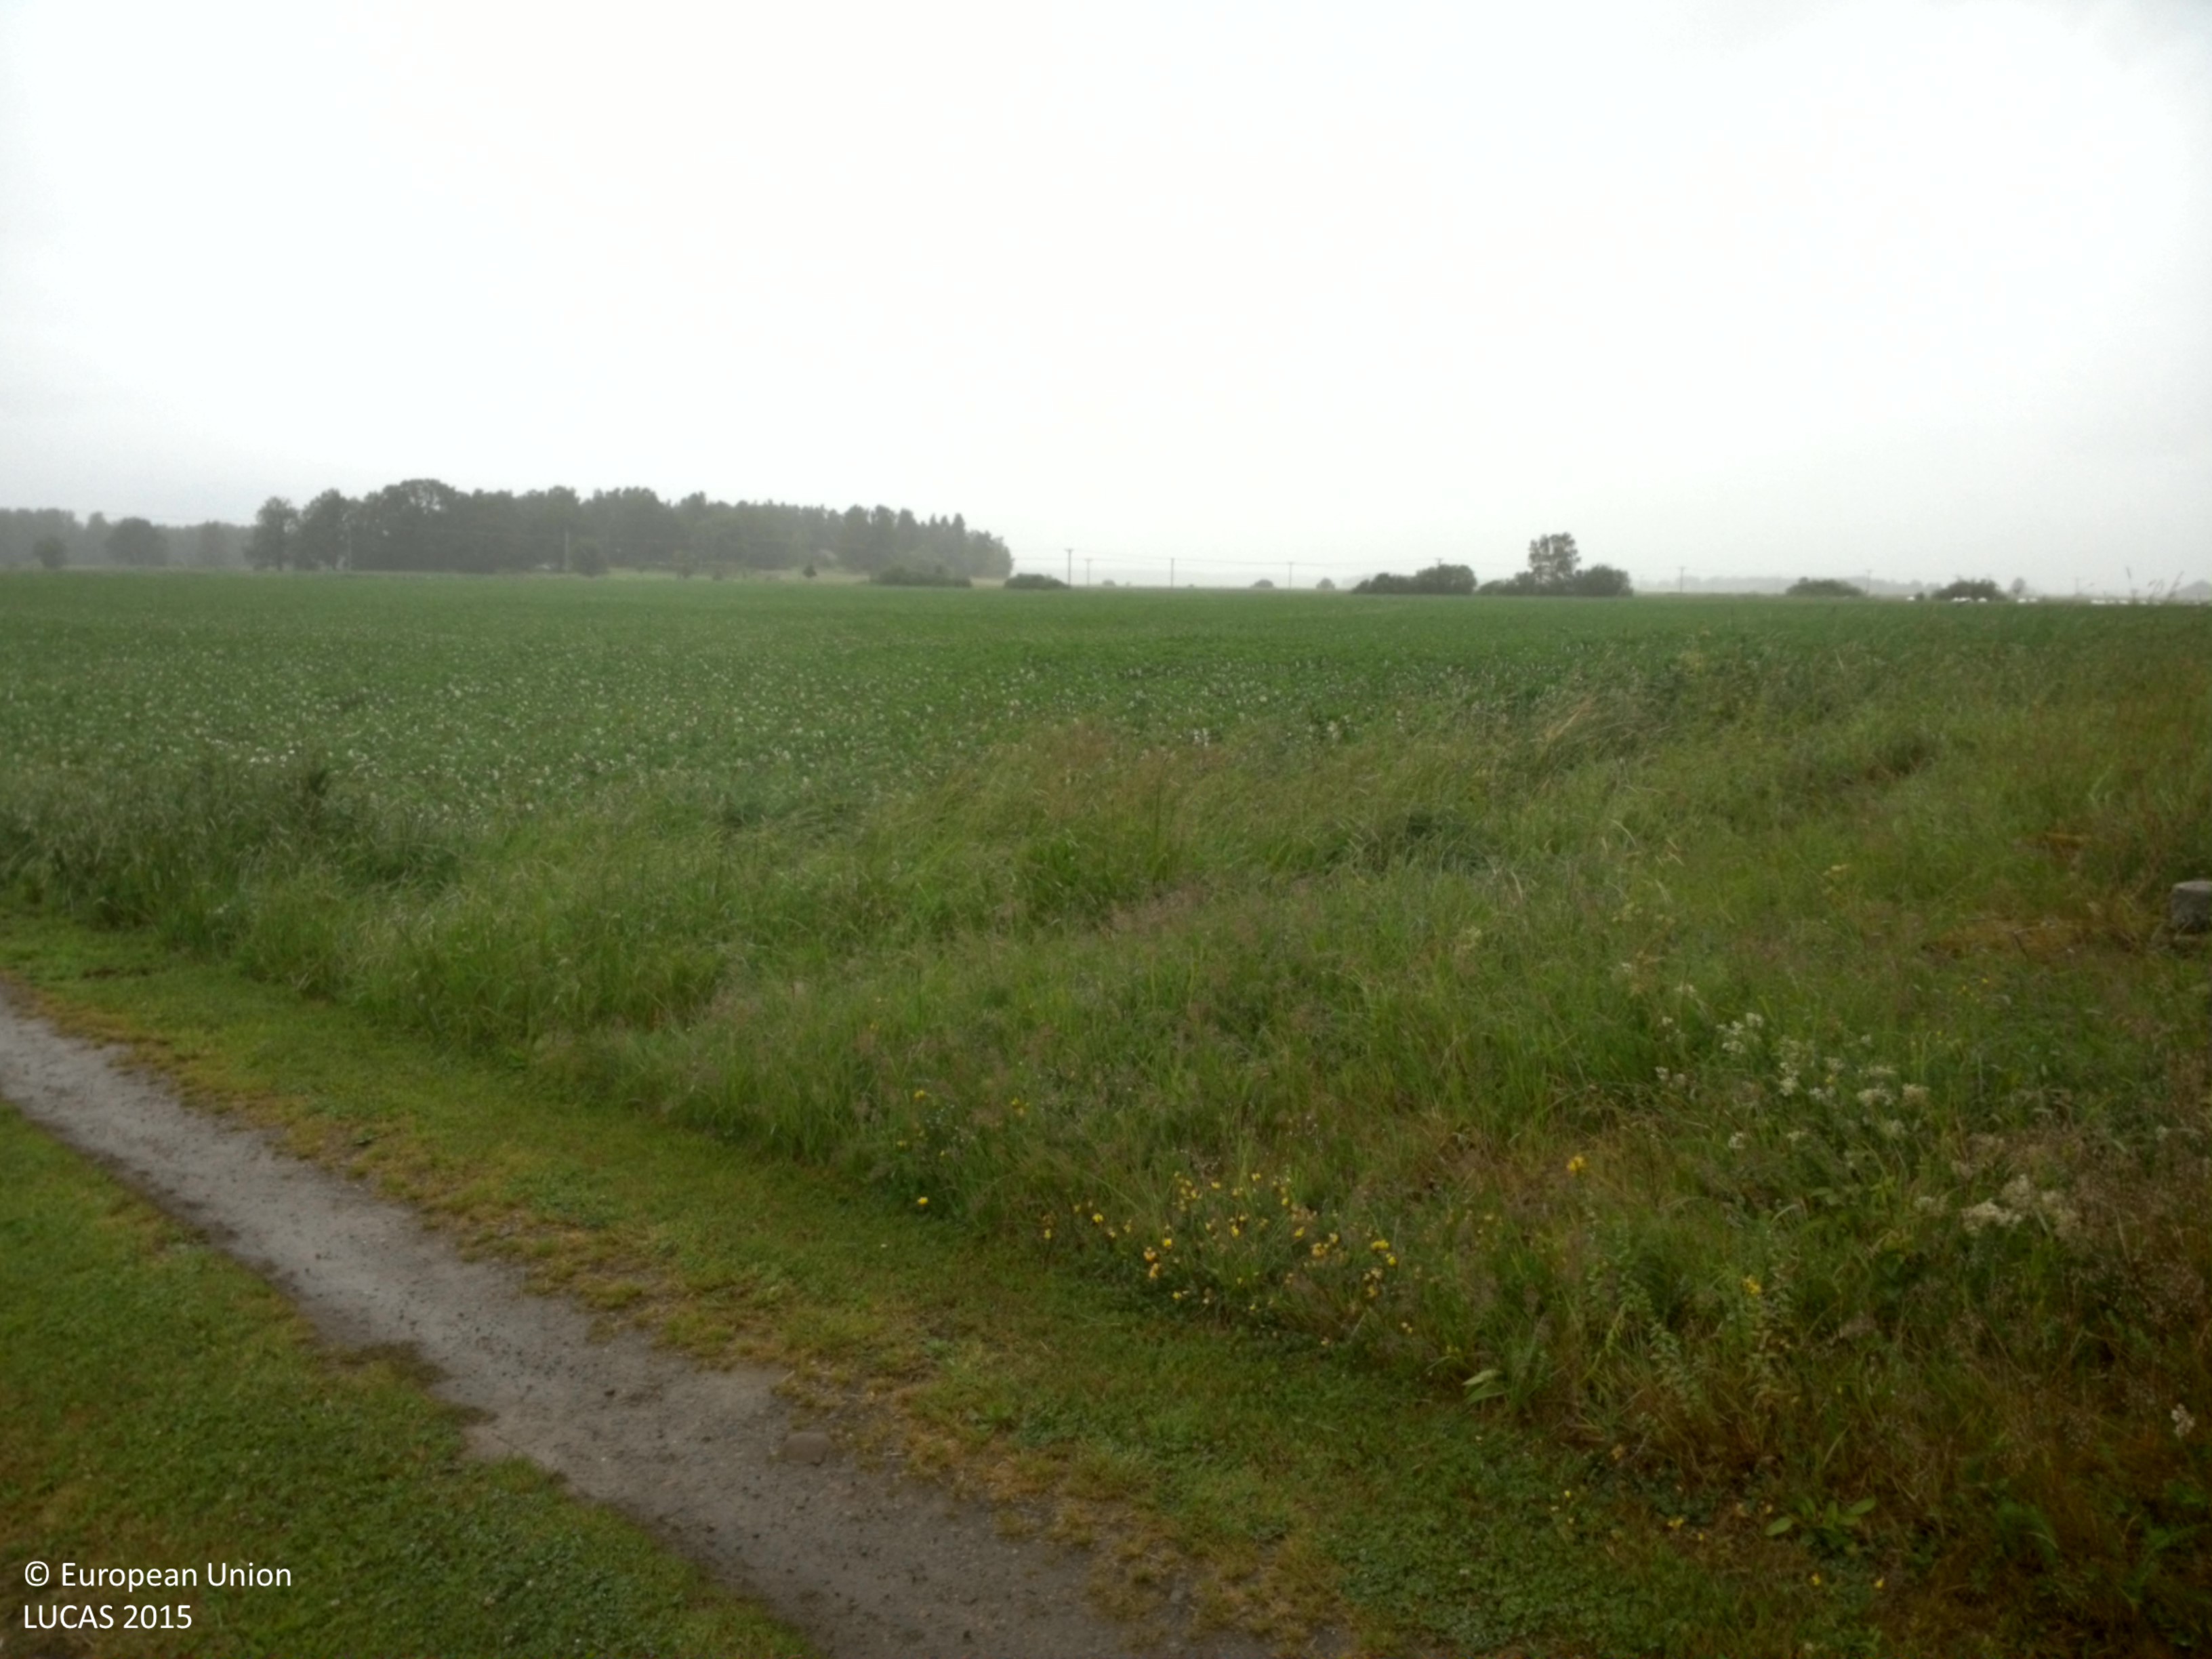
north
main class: Cropland
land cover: Dry pulses
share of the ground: > 75 %
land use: Agriculture (excluding fallow land and kitchen gardens)
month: July
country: SE
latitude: 58.5404
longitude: 13.9275
